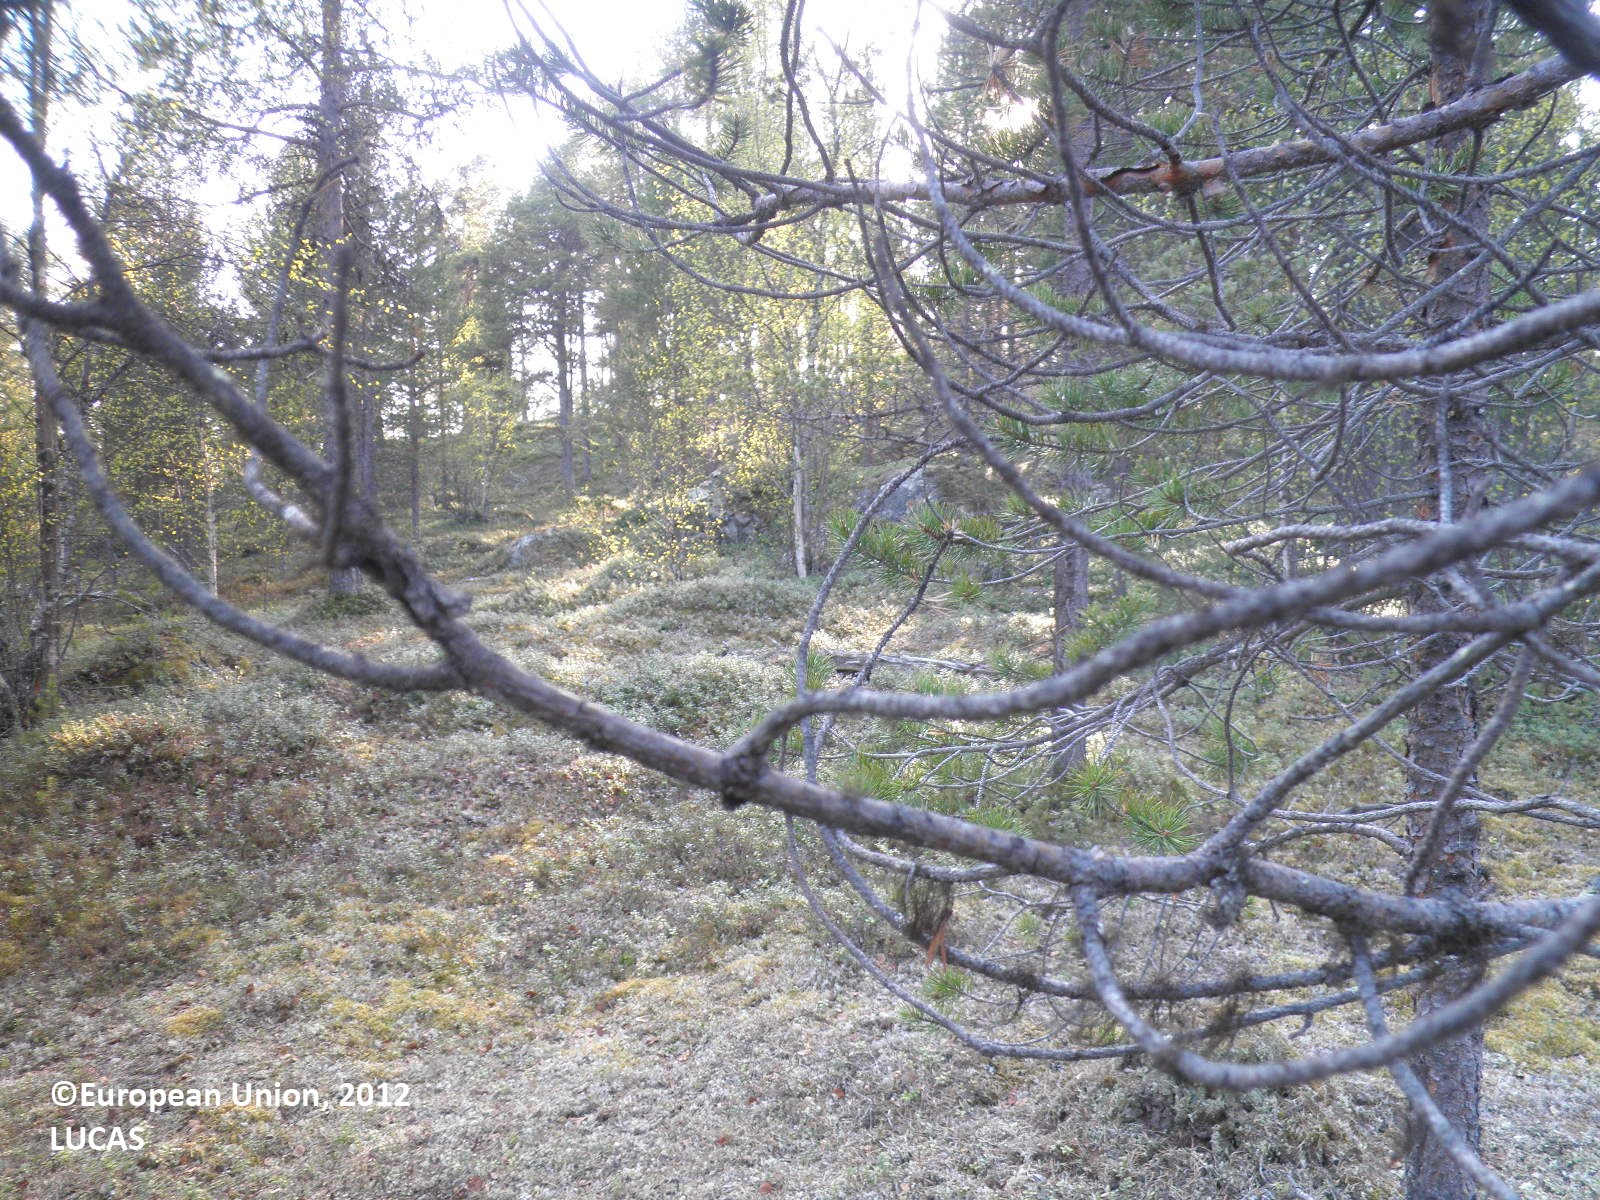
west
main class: Woodland
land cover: Pine dominated coniferous woodland
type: boreal forest
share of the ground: > 75 %
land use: Forestry
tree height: > 5 m
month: June
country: FI
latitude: 69.0712
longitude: 27.5034
